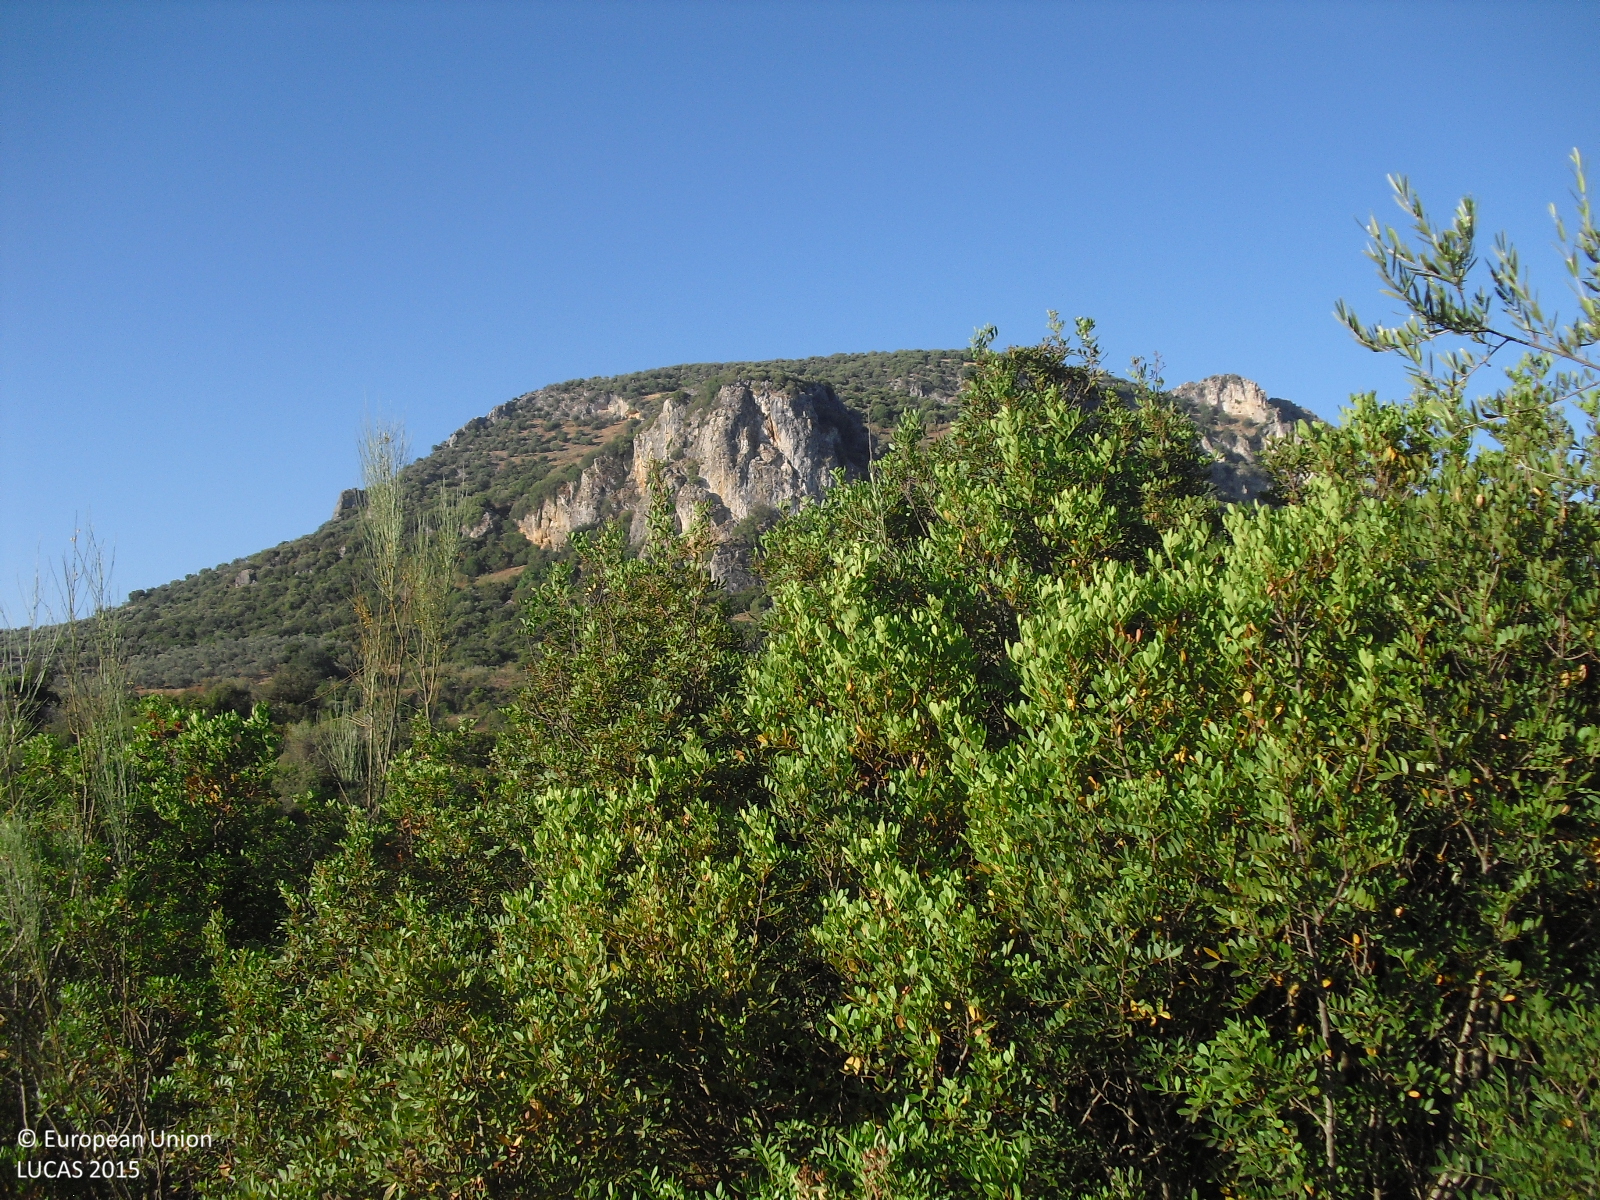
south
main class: Shrubland
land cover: Shrubland with sparse tree cover
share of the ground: 50 - 75 %
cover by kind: shrubs 50 %, herbaceous plants 45 %, broadleaved forest trees 5 %
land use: Agriculture (excluding fallow land and kitchen gardens)
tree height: < 5 m
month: July
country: ES
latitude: 36.9881
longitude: -5.3651
